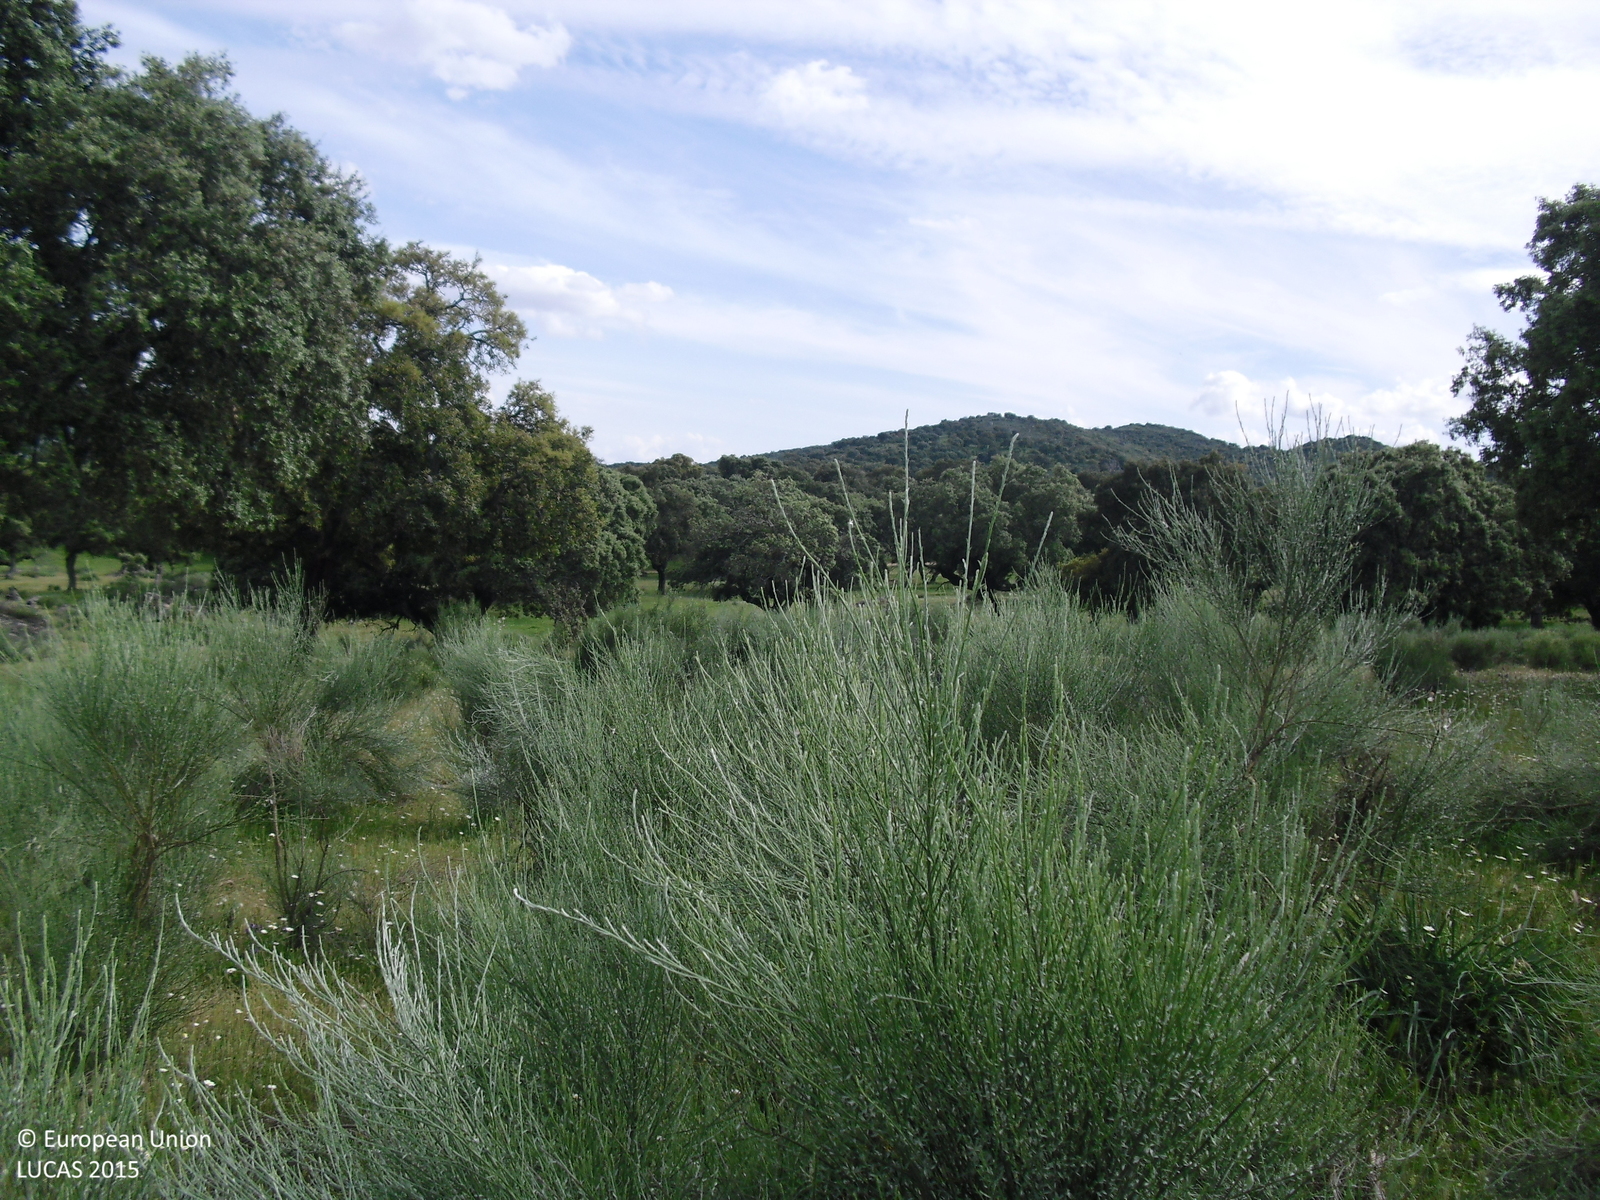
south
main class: Shrubland
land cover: Shrubland with sparse tree cover
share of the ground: > 75 %
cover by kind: shrubs 75 %, herbaceous plants 20 %, broadleaved forest trees 5 %
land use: Agriculture (excluding fallow land and kitchen gardens)
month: April
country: ES
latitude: 39.2942
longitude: -6.0005
